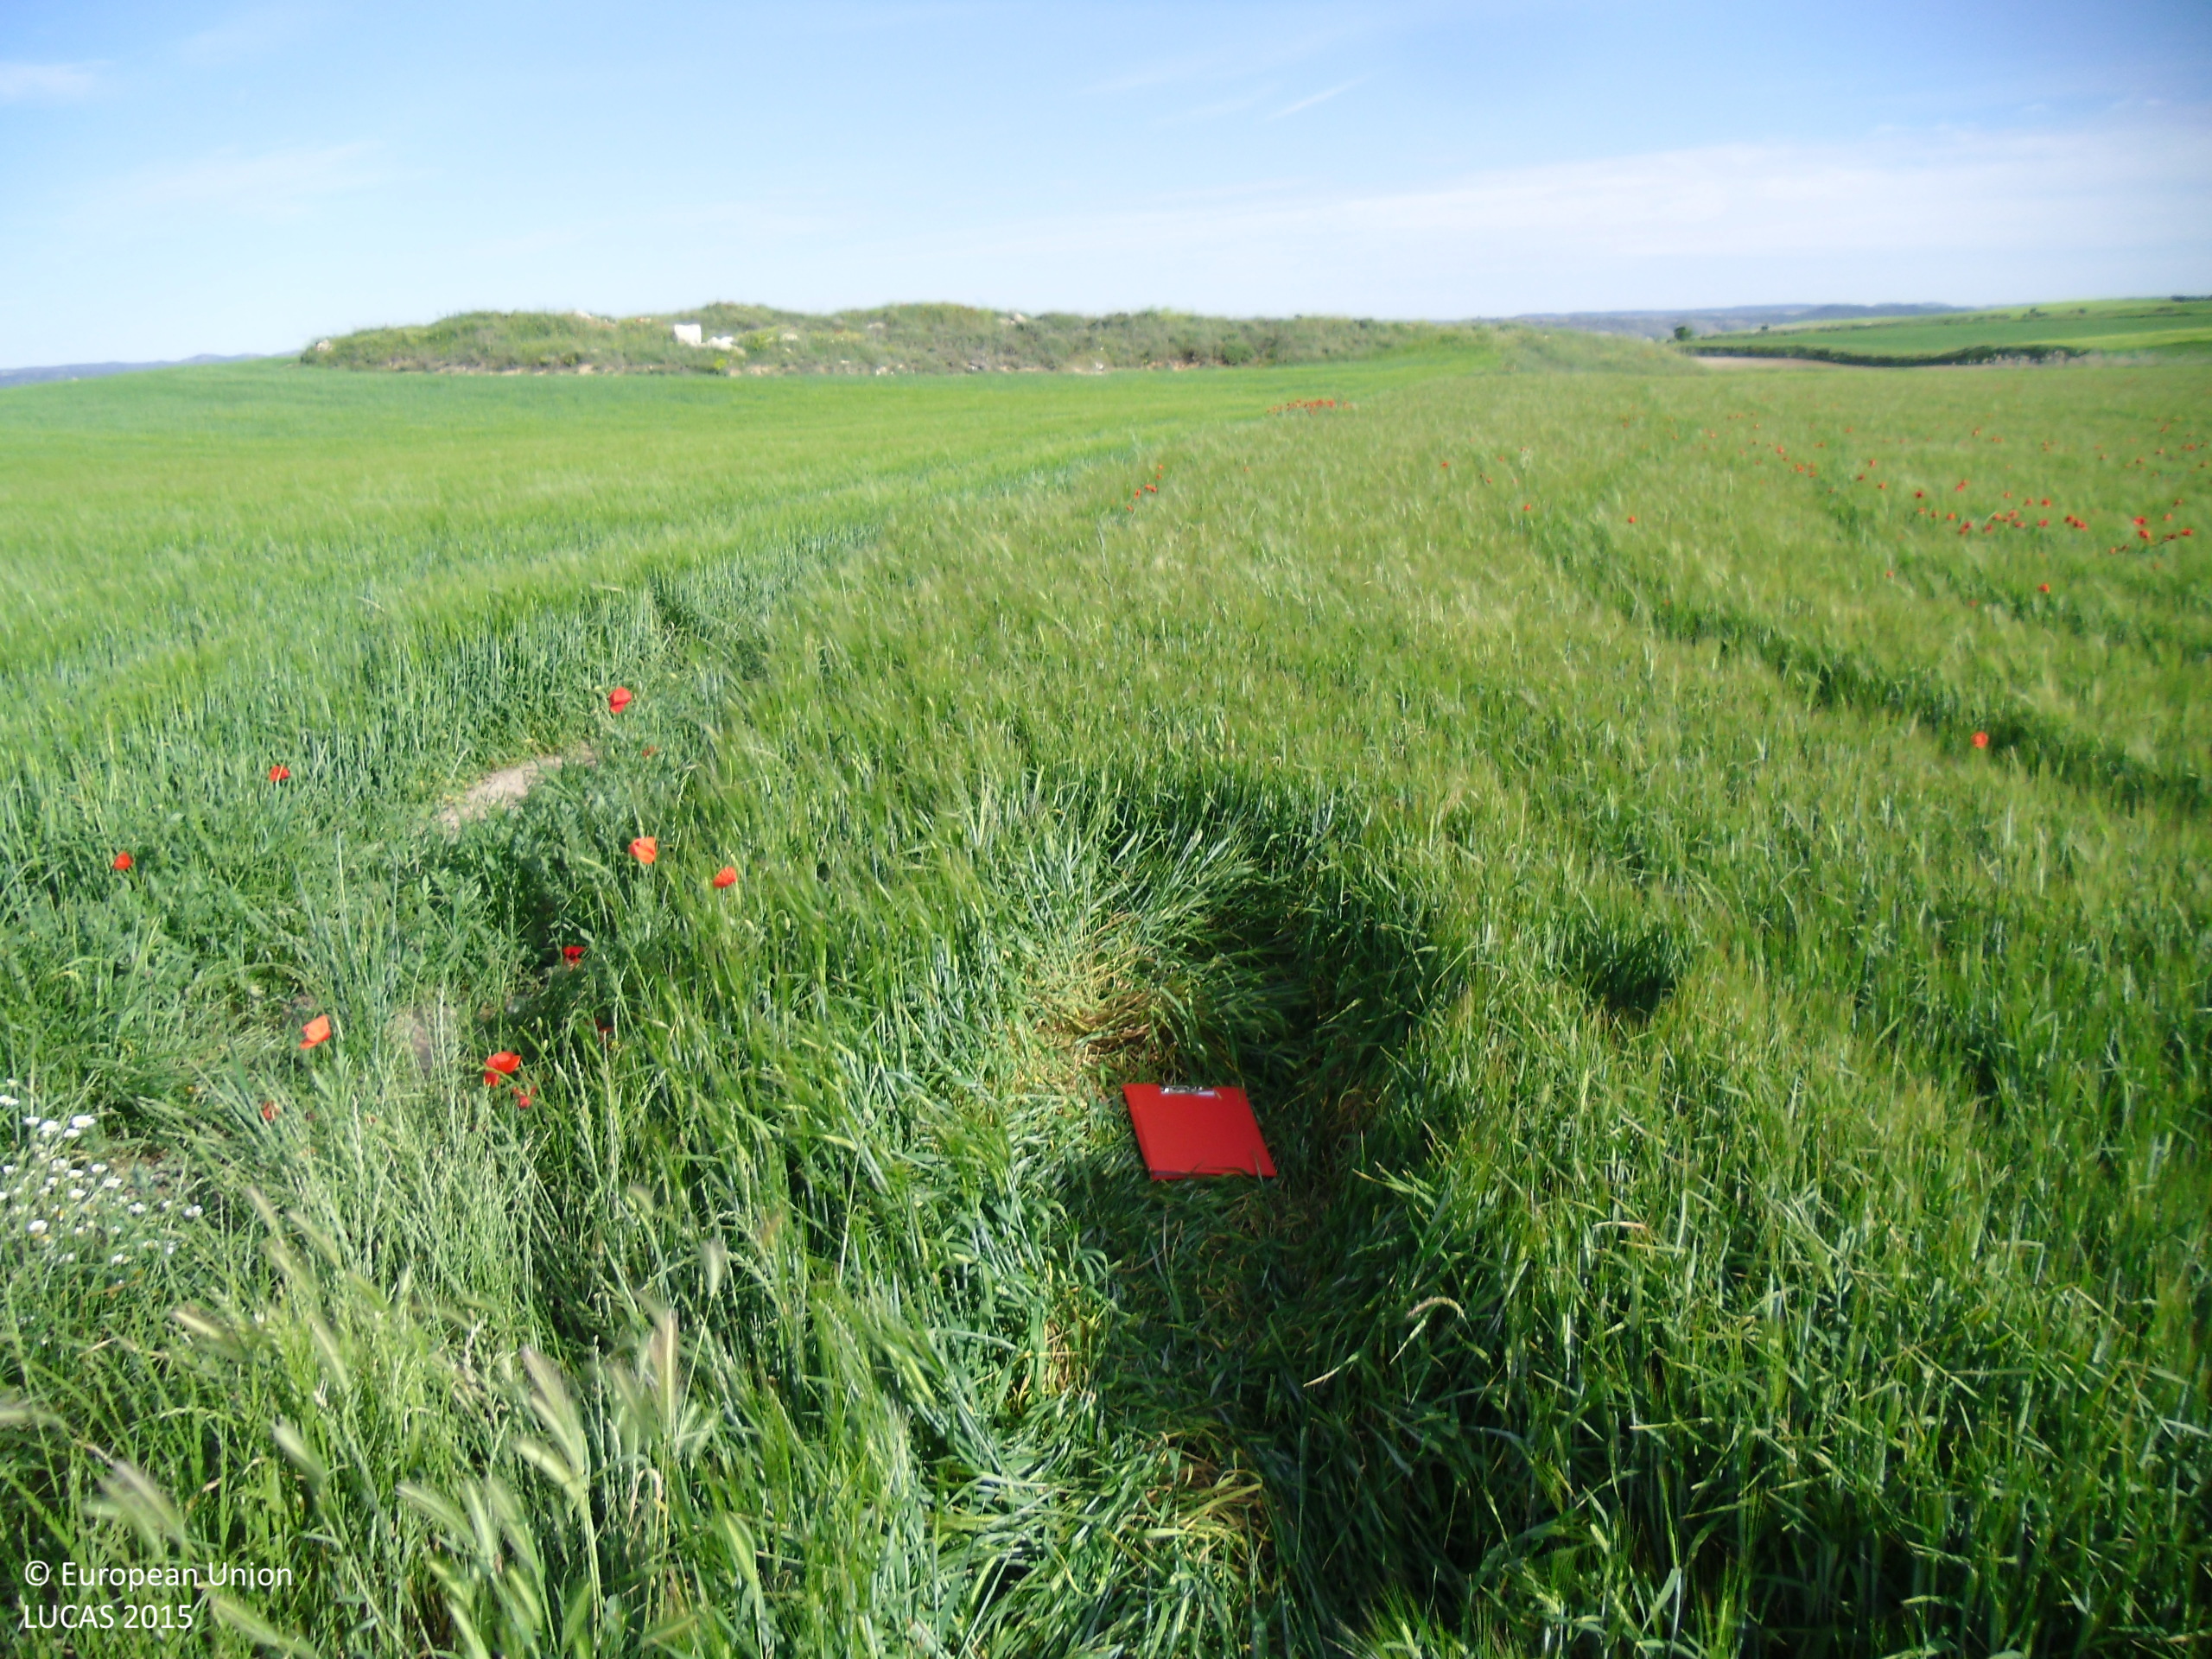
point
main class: Cropland
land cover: Barley
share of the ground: > 75 %
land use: Agriculture (excluding fallow land and kitchen gardens)
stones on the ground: < 10 %
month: May
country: ES
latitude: 40.3363
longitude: -2.9640
